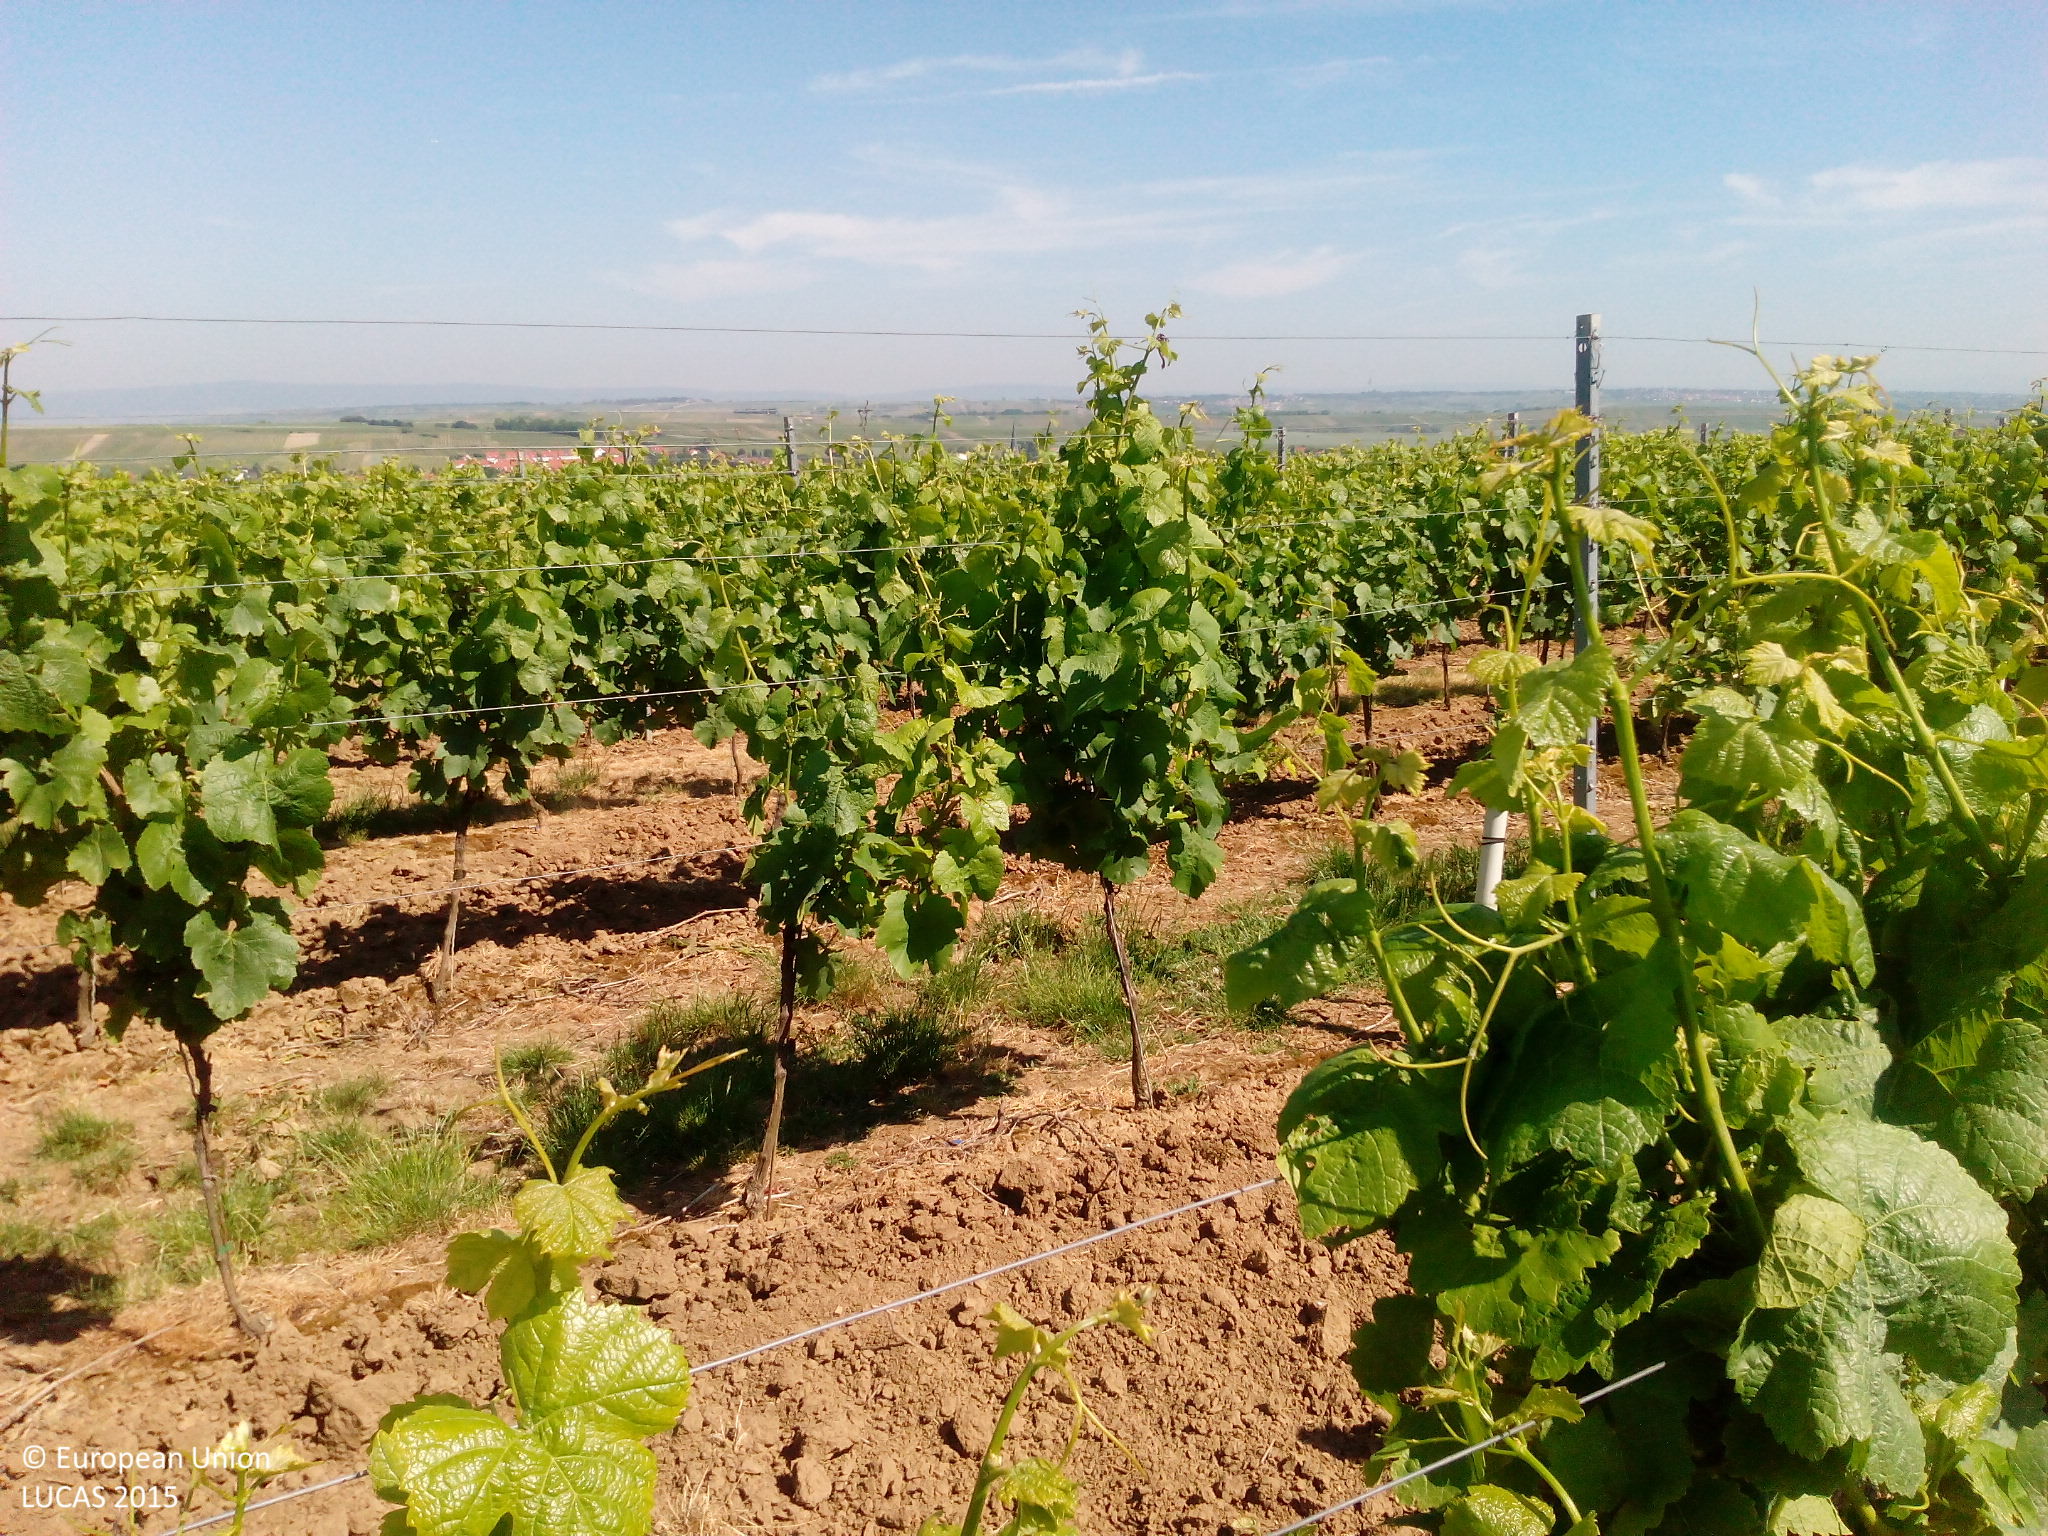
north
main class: Cropland
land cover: Vineyards
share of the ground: 50 - 75 %
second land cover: Grassland without tree/shrub cover
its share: 50 - 75 %
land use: Agriculture (excluding fallow land and kitchen gardens)
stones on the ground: < 10 %
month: June
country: DE
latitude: 49.8635
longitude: 8.1502
